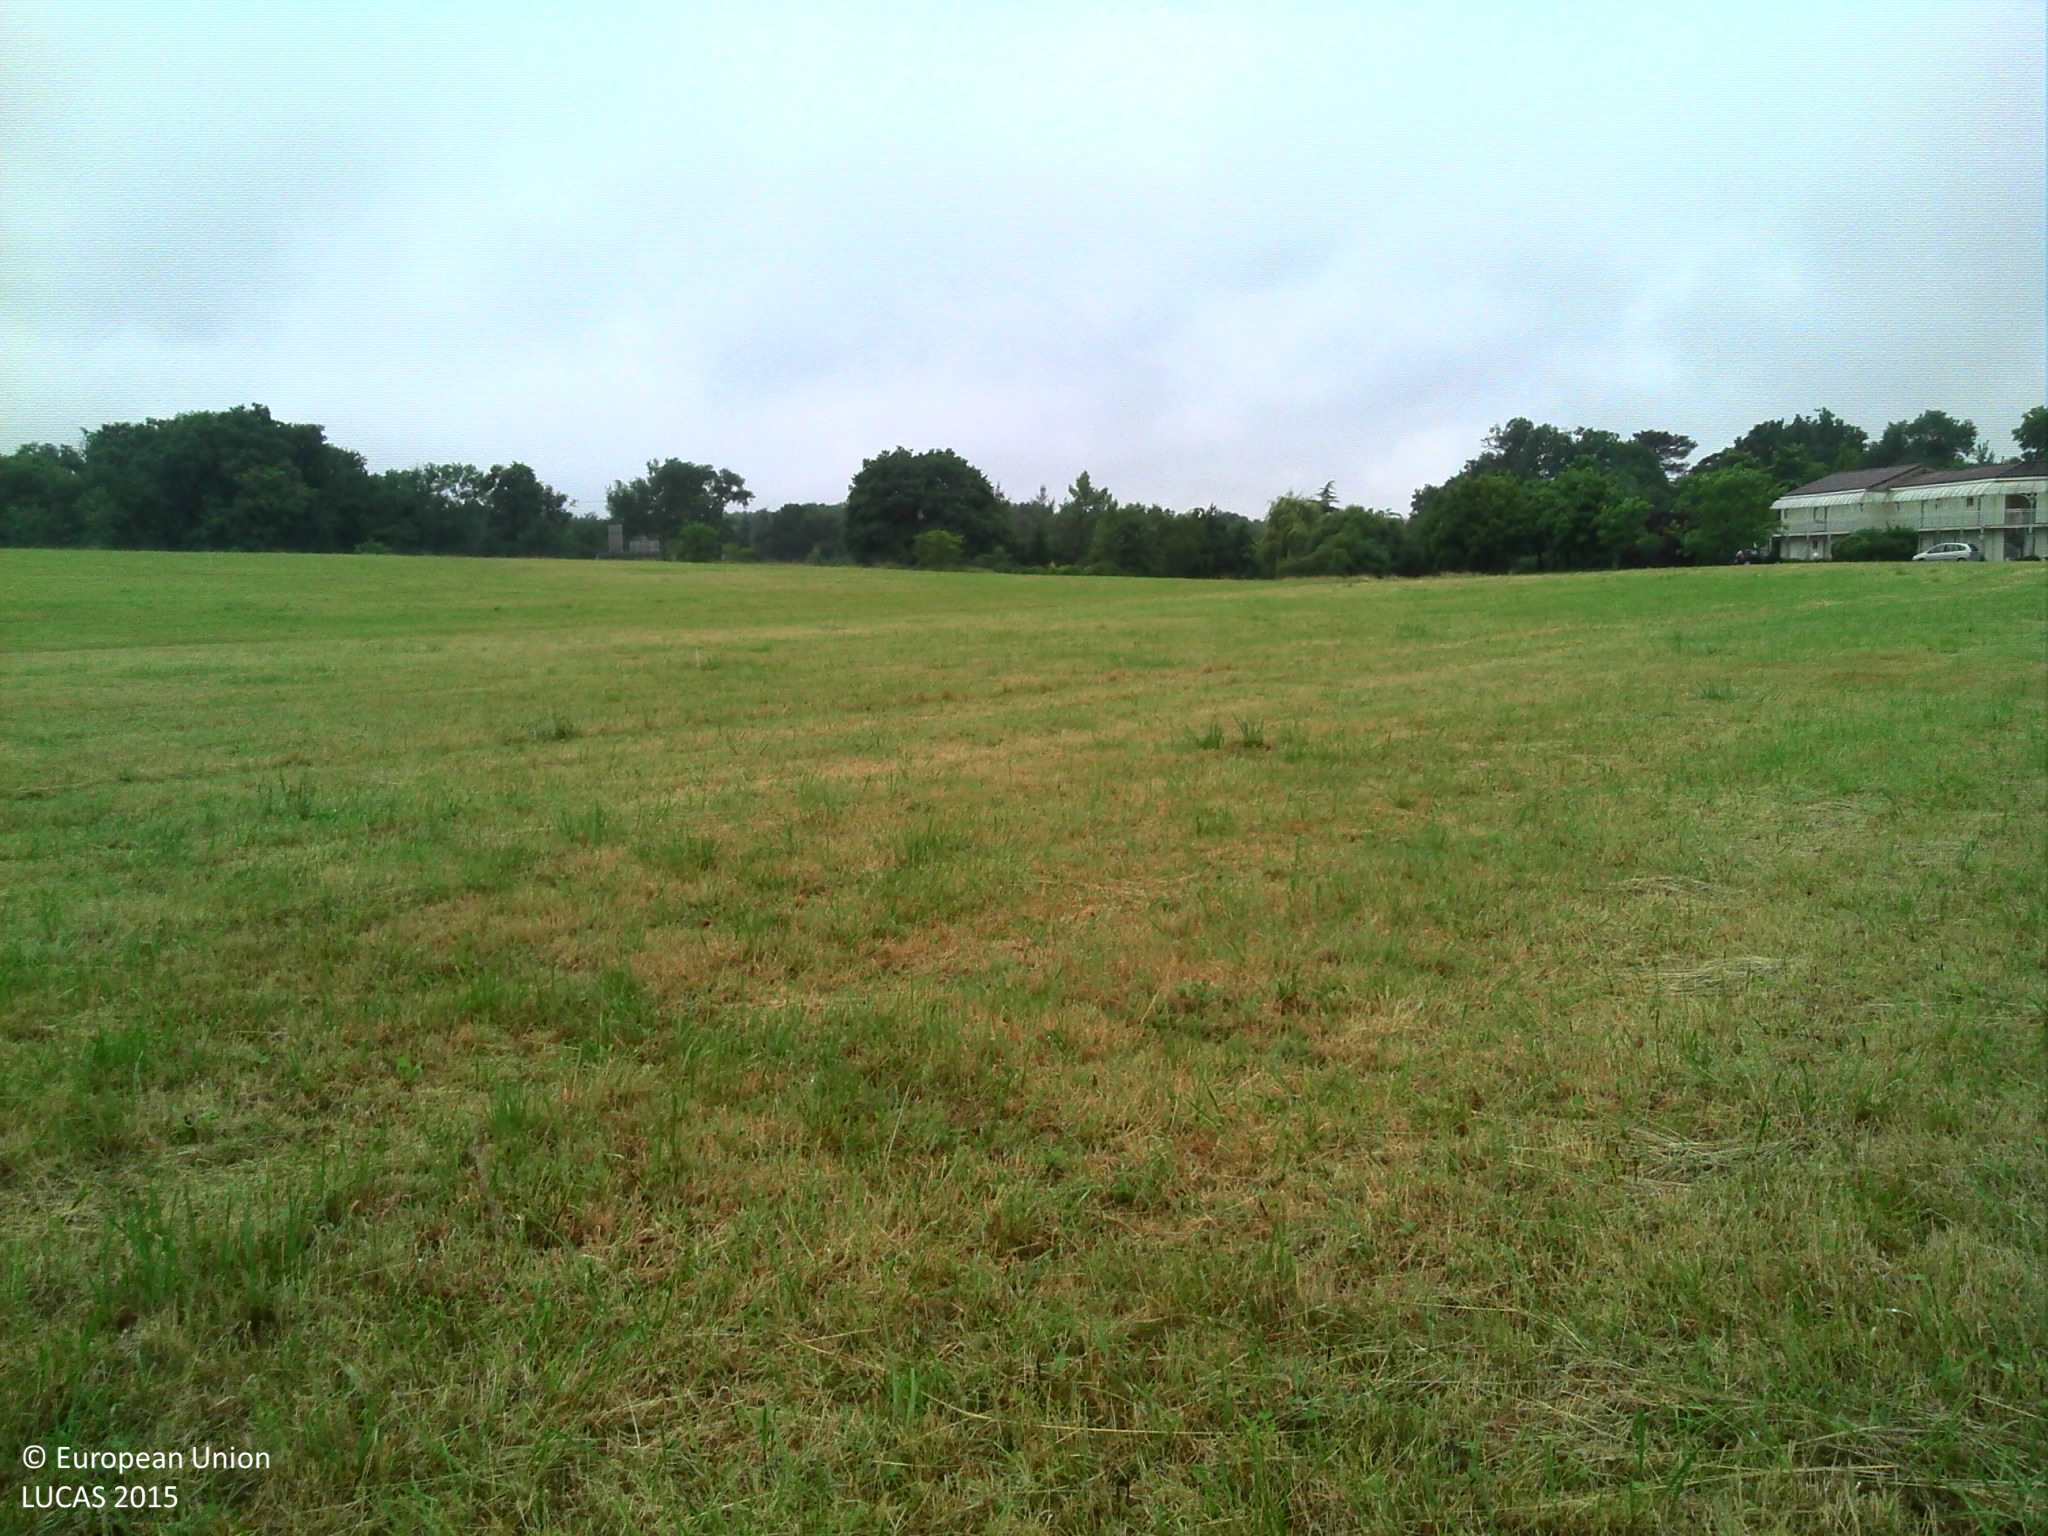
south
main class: Grassland
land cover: Grassland without tree/shrub cover
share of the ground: > 75 %
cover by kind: herbaceous plants 100 %
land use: Agriculture (excluding fallow land and kitchen gardens)
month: June
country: FR
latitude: 46.5433
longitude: 0.2915
